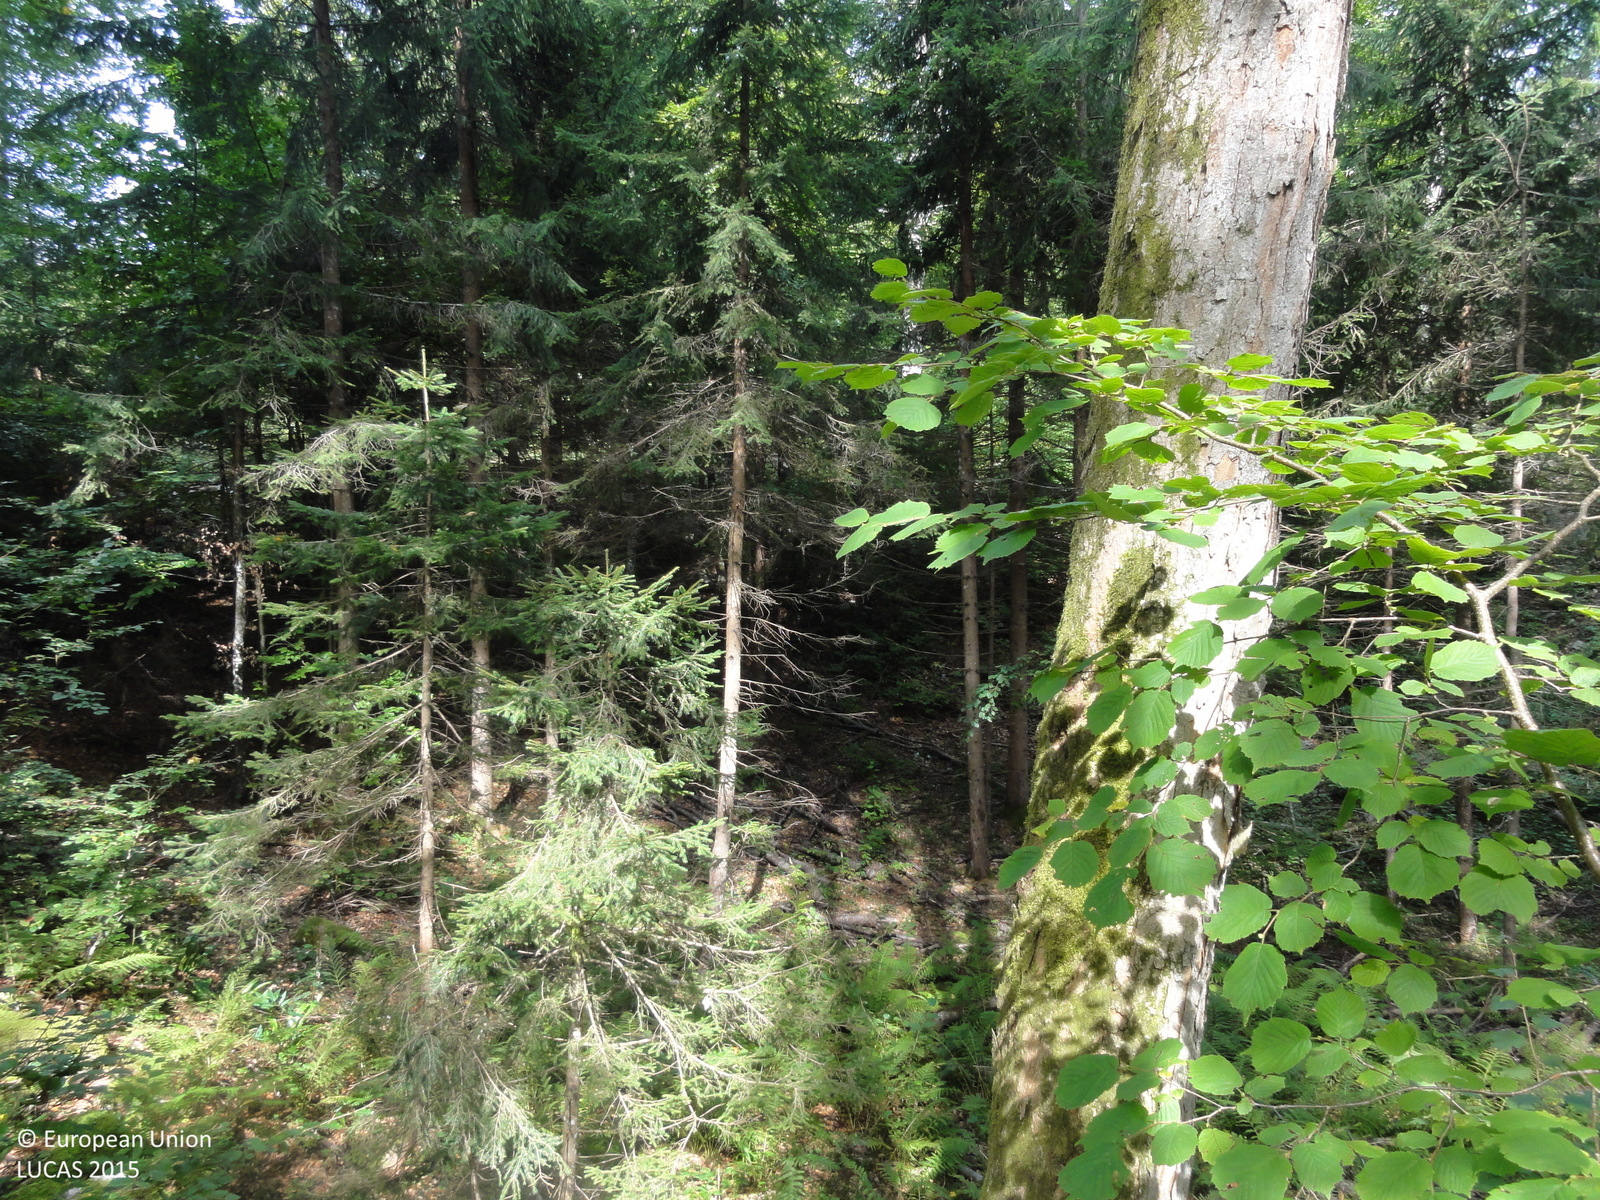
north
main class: Woodland
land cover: Broadleaved woodland
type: beech forest
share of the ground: > 75 %
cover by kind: broadleaved forest trees 90 %, coniferous forest trees 10 %
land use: Forestry
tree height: > 5 m
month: September
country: SI
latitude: 45.5806
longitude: 15.0838
